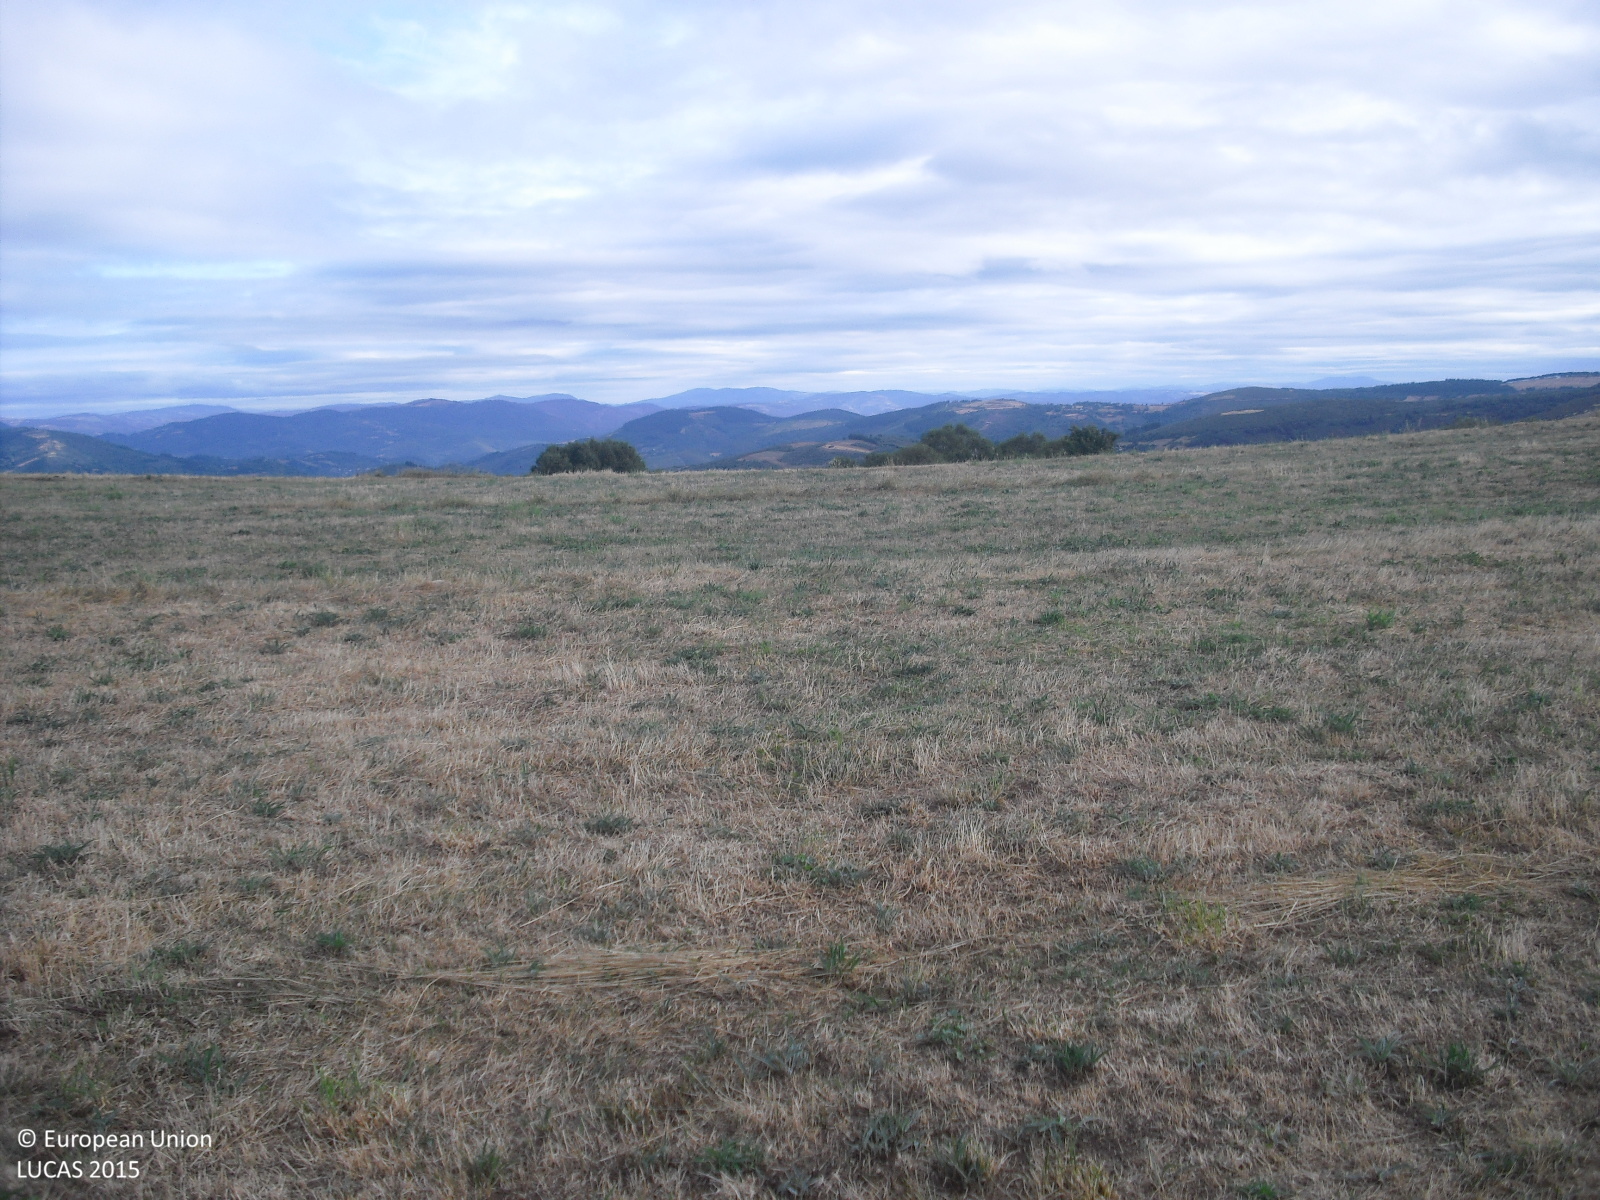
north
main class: Cropland
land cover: Temporary grasslands
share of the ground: > 75 %
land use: Agriculture (excluding fallow land and kitchen gardens)
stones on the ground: < 10 %
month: July
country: ES
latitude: 42.7381
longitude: -7.0764
